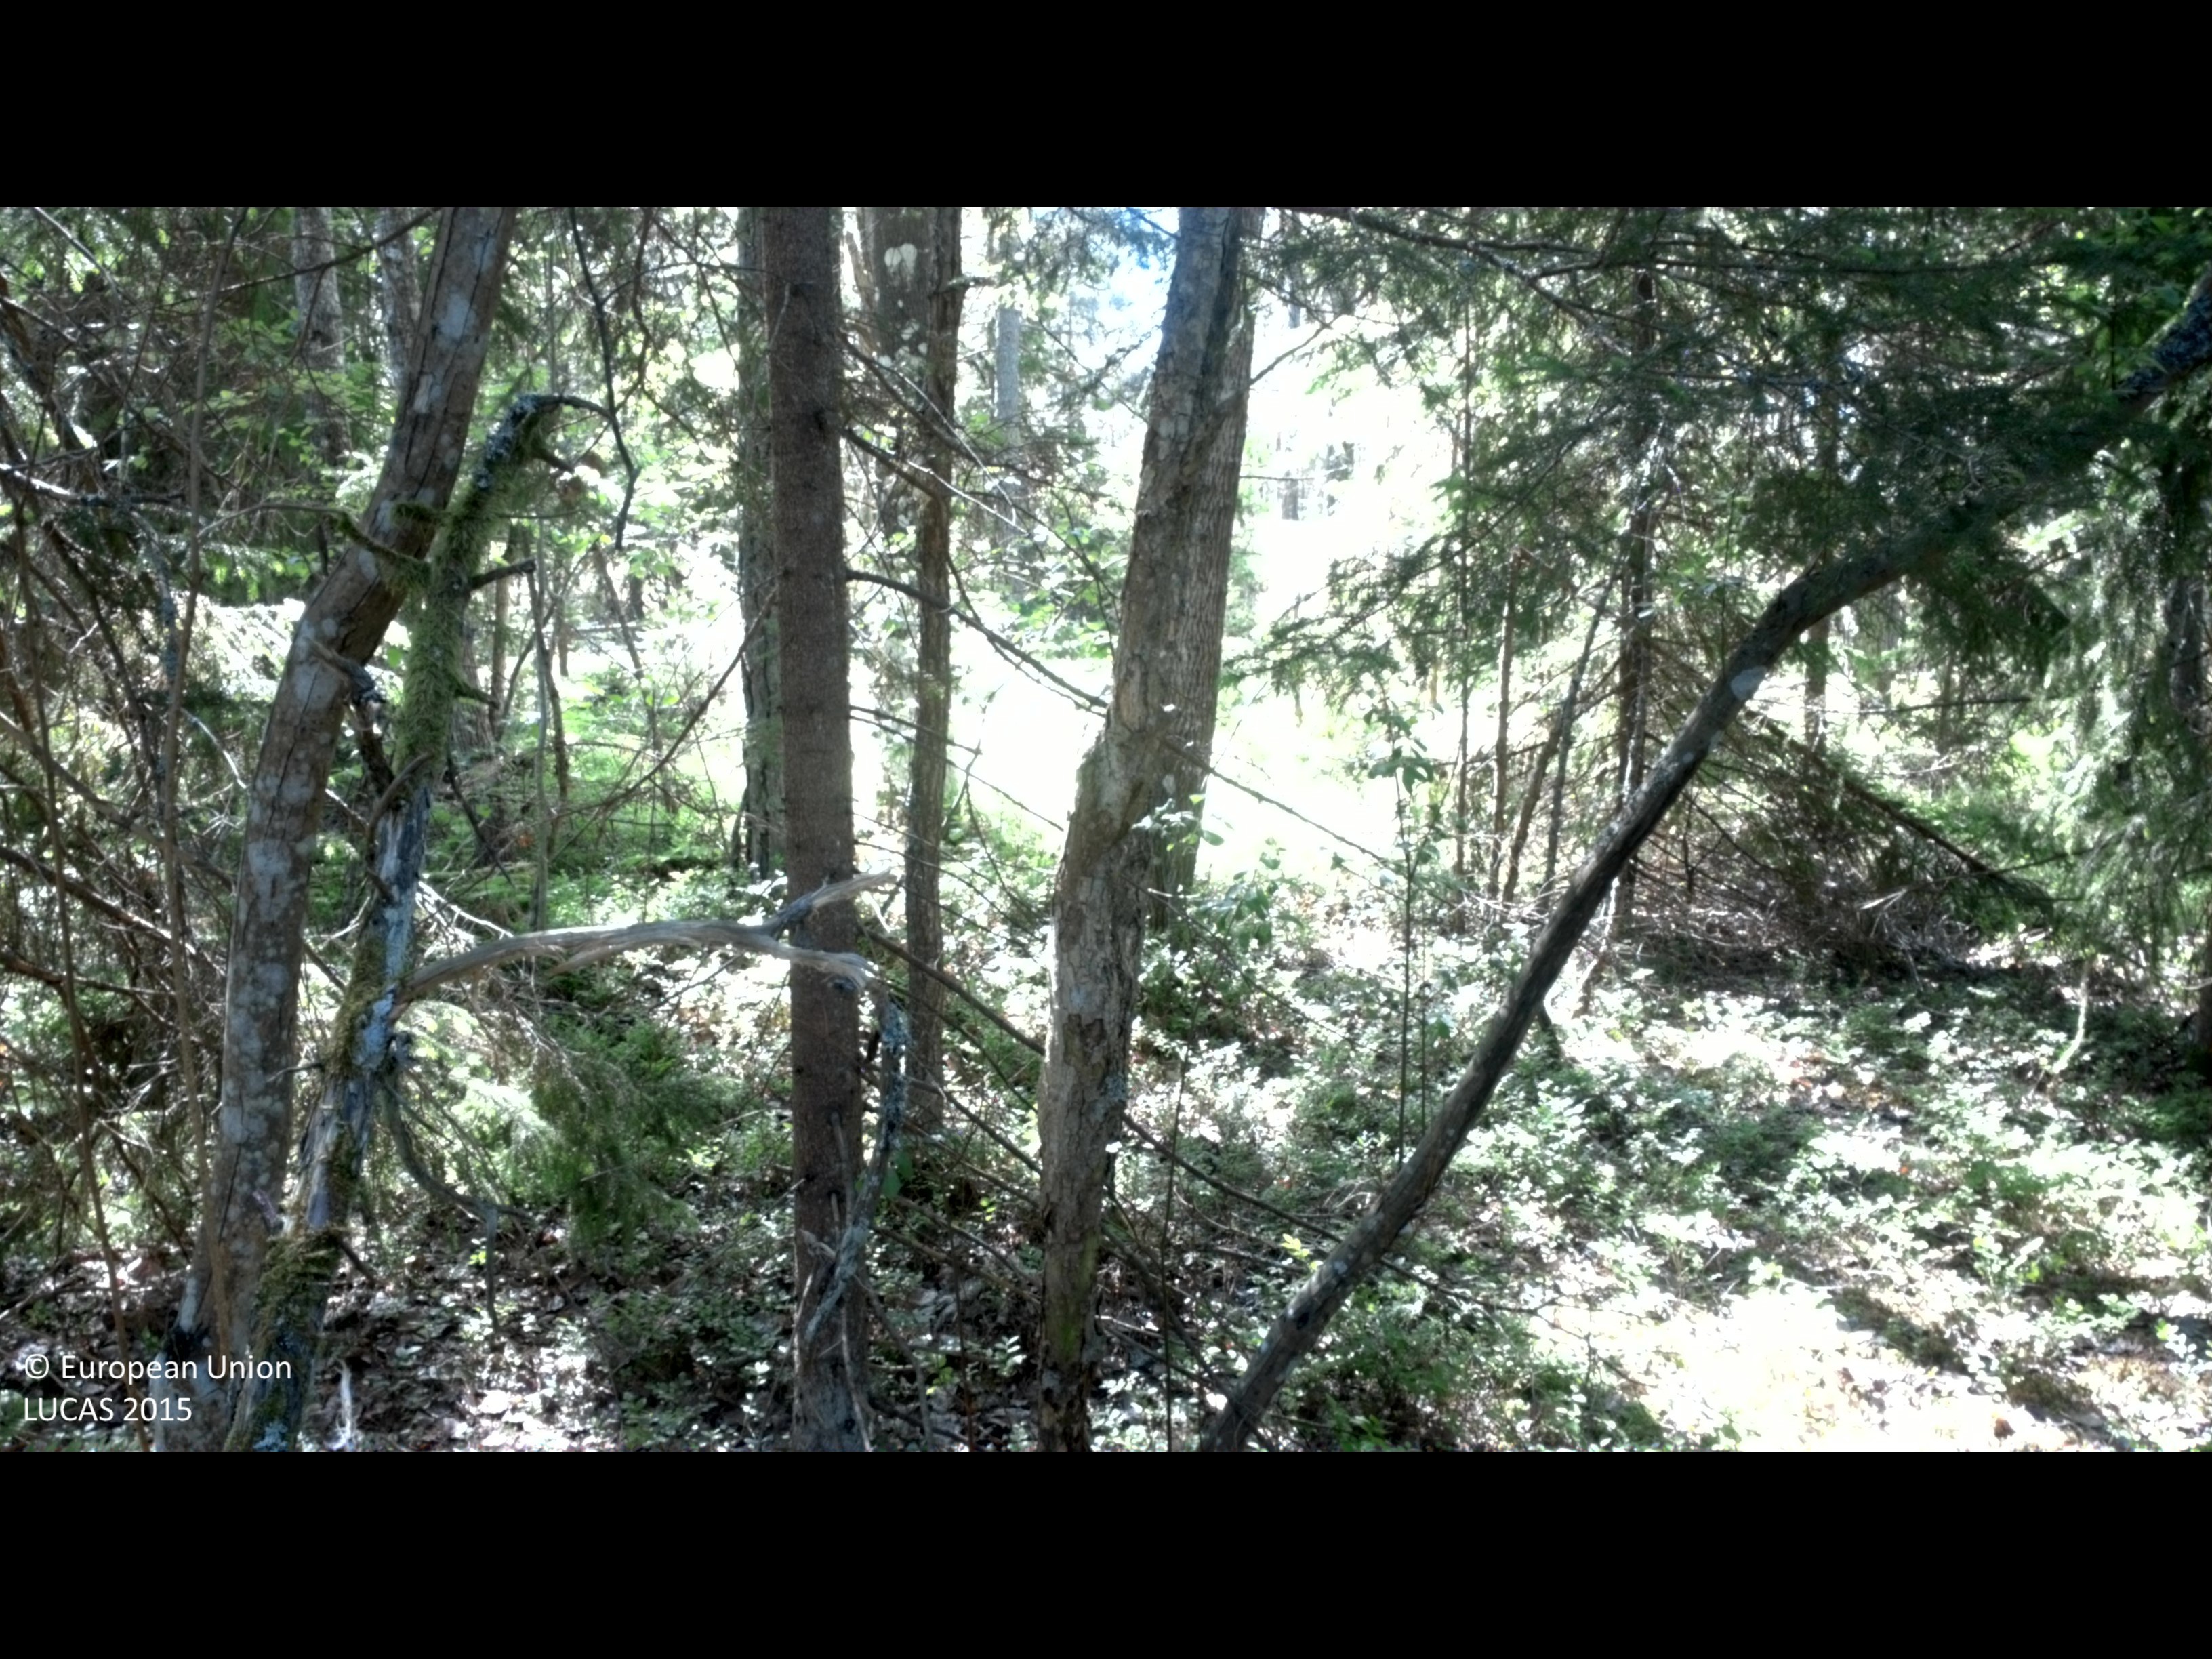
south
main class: Woodland
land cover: Spruce dominated mixed woodland
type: hemiboreal forest and nemoral coniferous forest and mixed broadleaved-coniferous forest
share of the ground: > 75 %
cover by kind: coniferous forest trees 55 %, broadleaved forest trees 25 %, shrubs 10 %, herbaceous plants 5 %, lichens and mosses 5 %
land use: Forestry
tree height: > 5 m
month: June
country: SE
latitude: 57.7146
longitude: 16.5957
